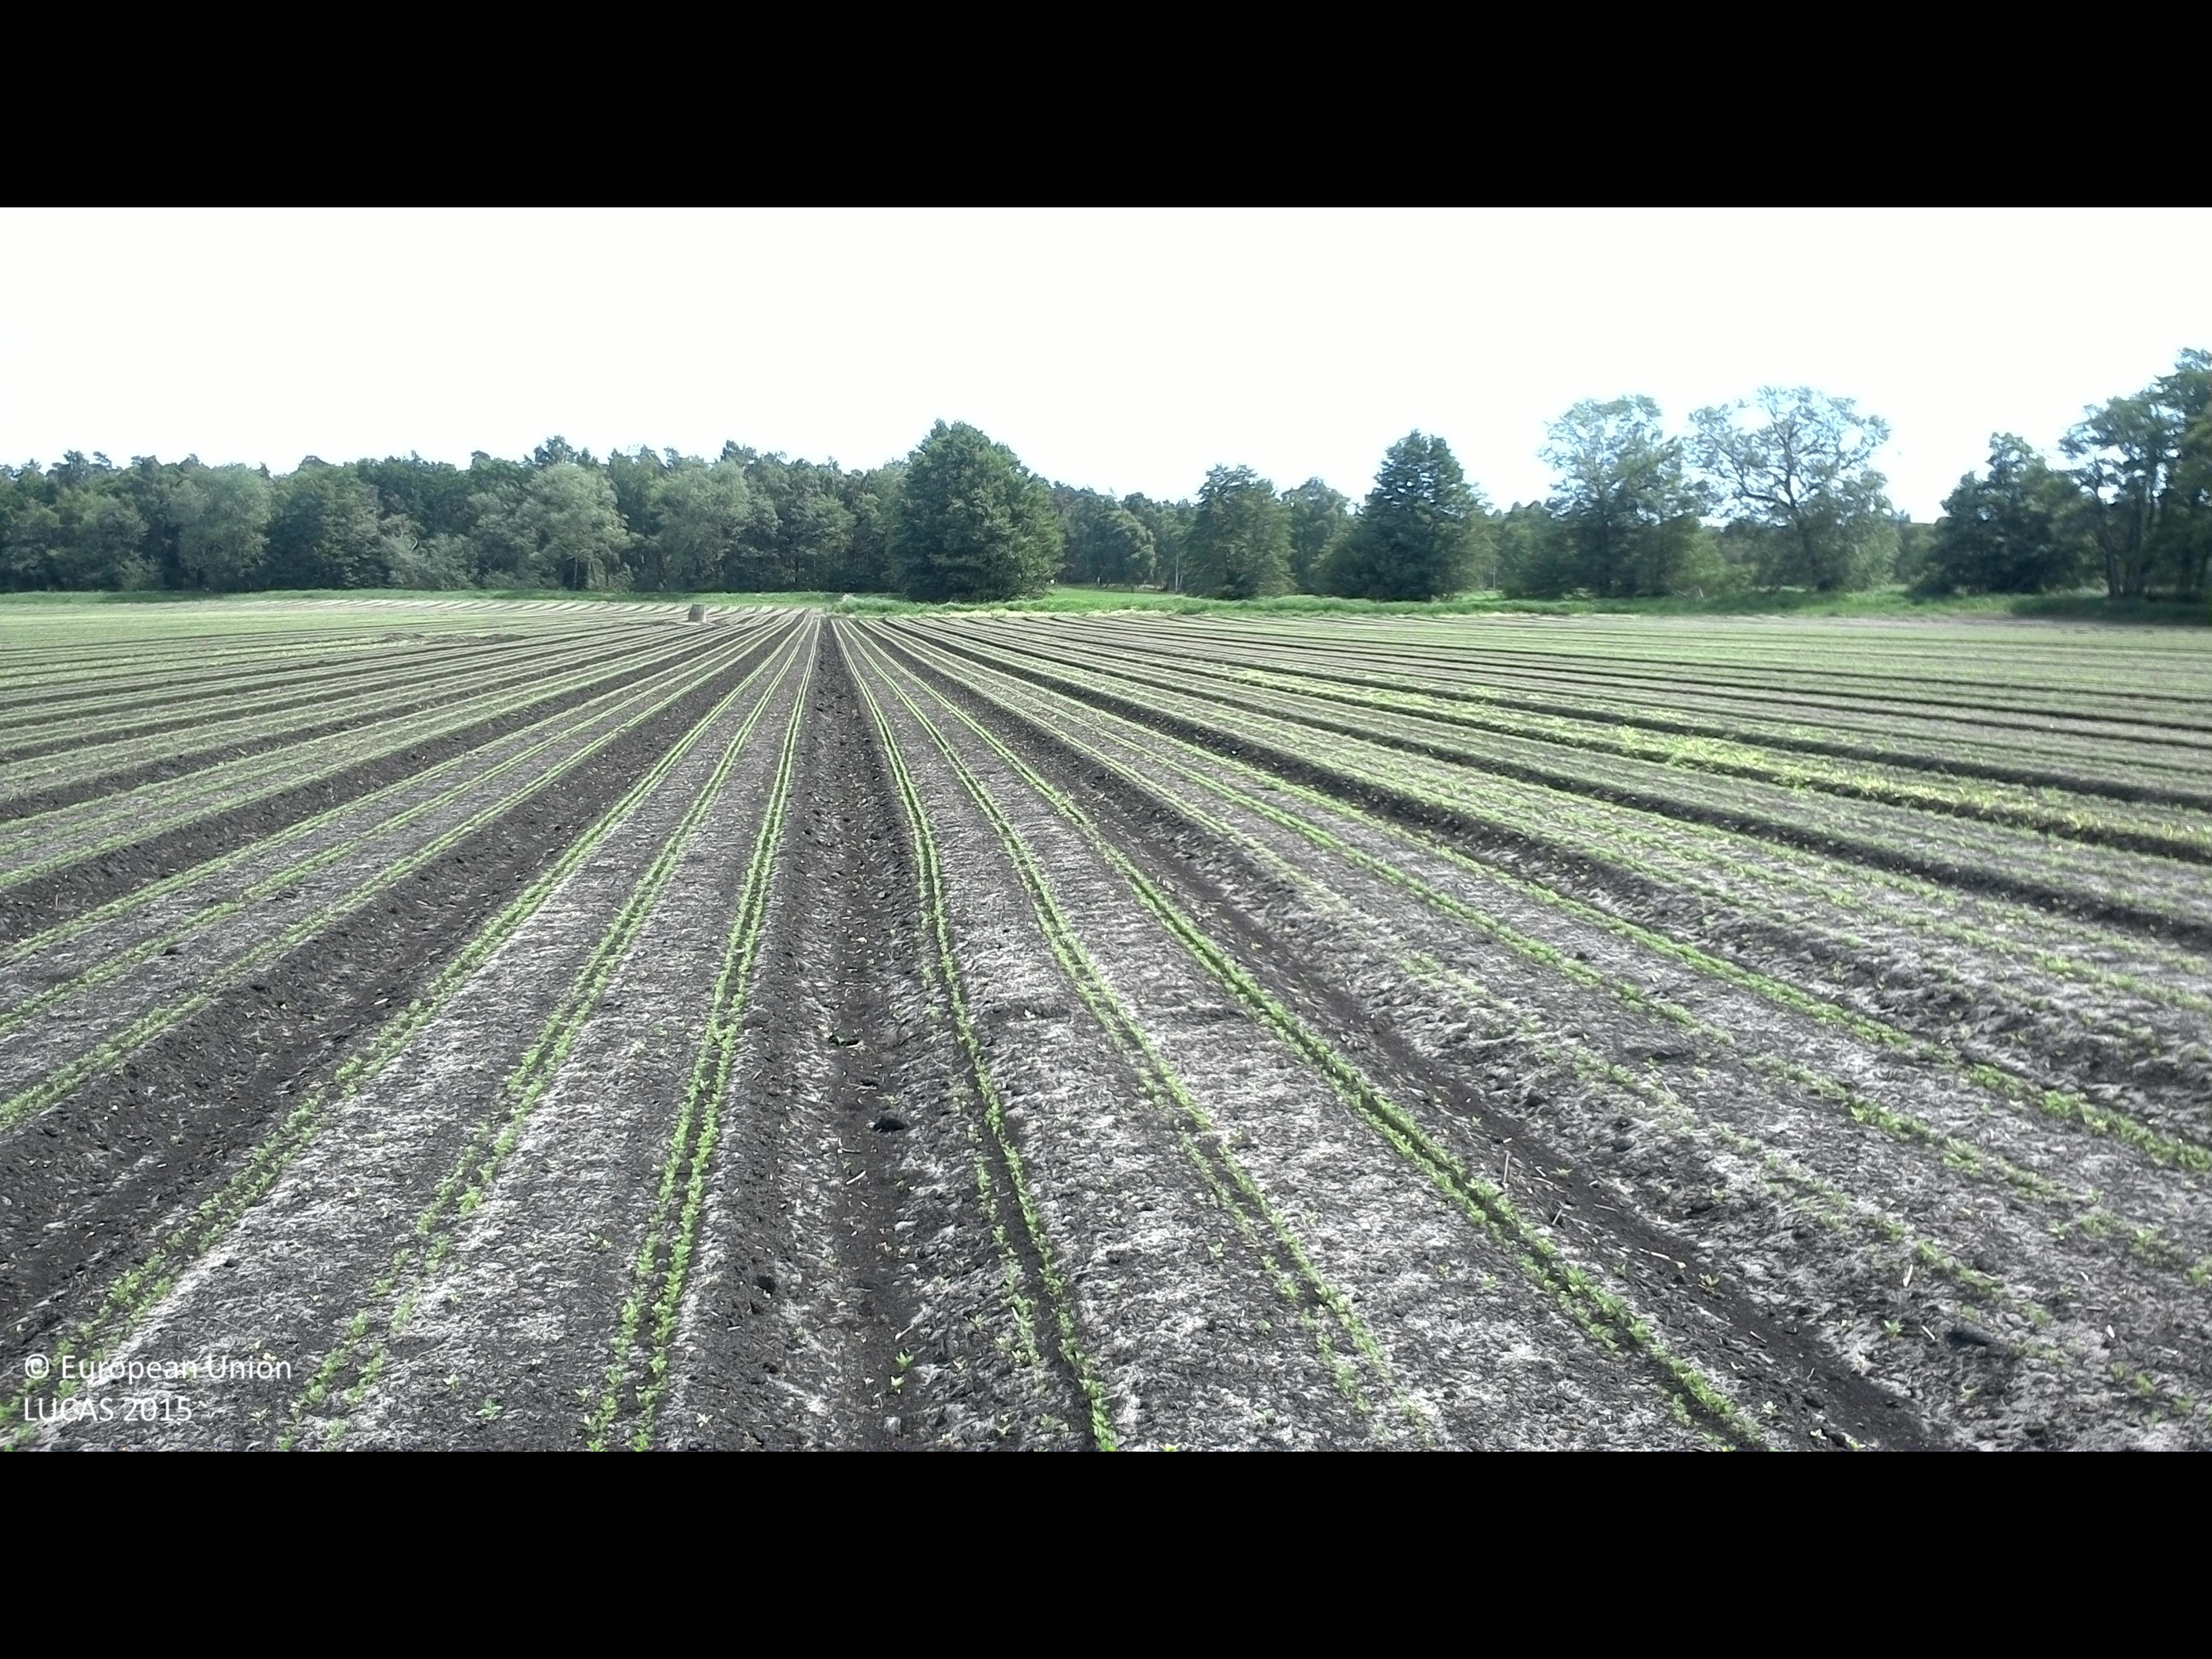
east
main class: Cropland
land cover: Other root crops
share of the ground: 10 - 25 %
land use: Agriculture (excluding fallow land and kitchen gardens)
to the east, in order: Other root crops; Grass margins; Ditches and canals; Groves; Pine dominated coniferous woodland
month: June
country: SE
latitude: 55.8143
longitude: 14.1633
